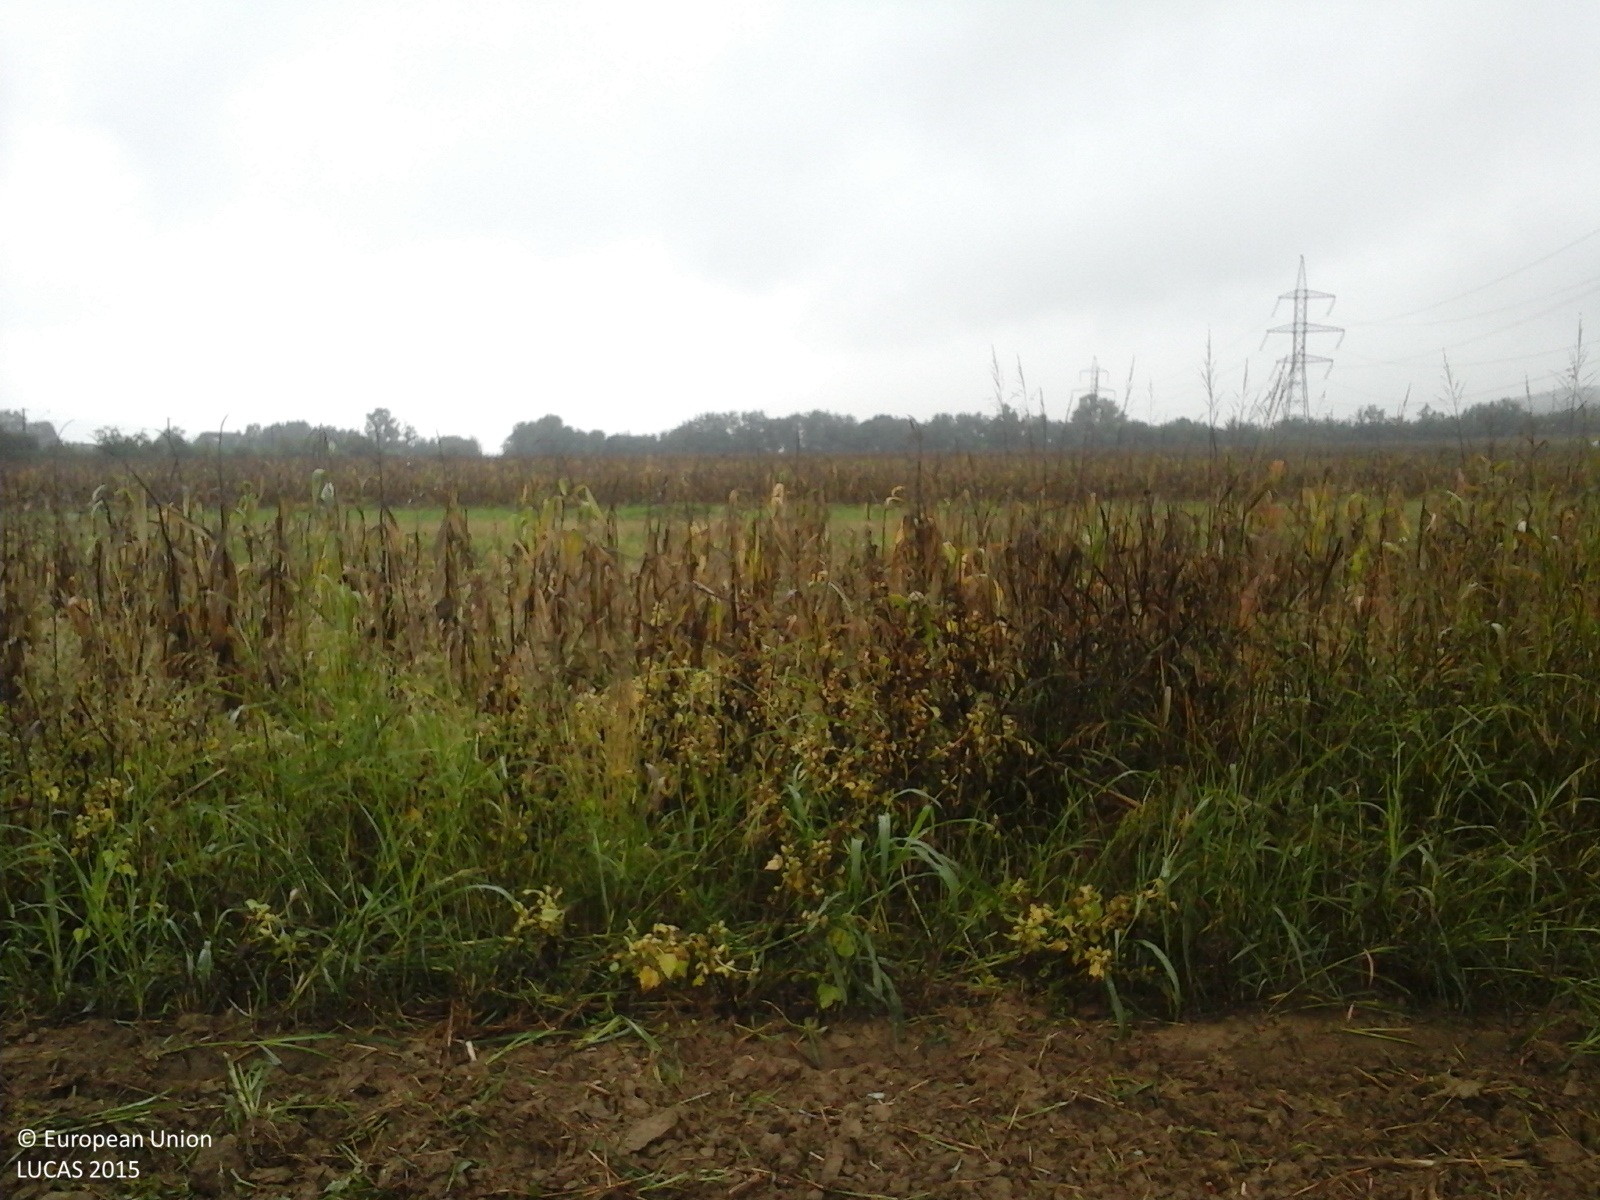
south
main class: Cropland
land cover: Common wheat
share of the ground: < 10 %
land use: Agriculture (excluding fallow land and kitchen gardens)
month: September
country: RO
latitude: 44.8686
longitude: 23.5108
